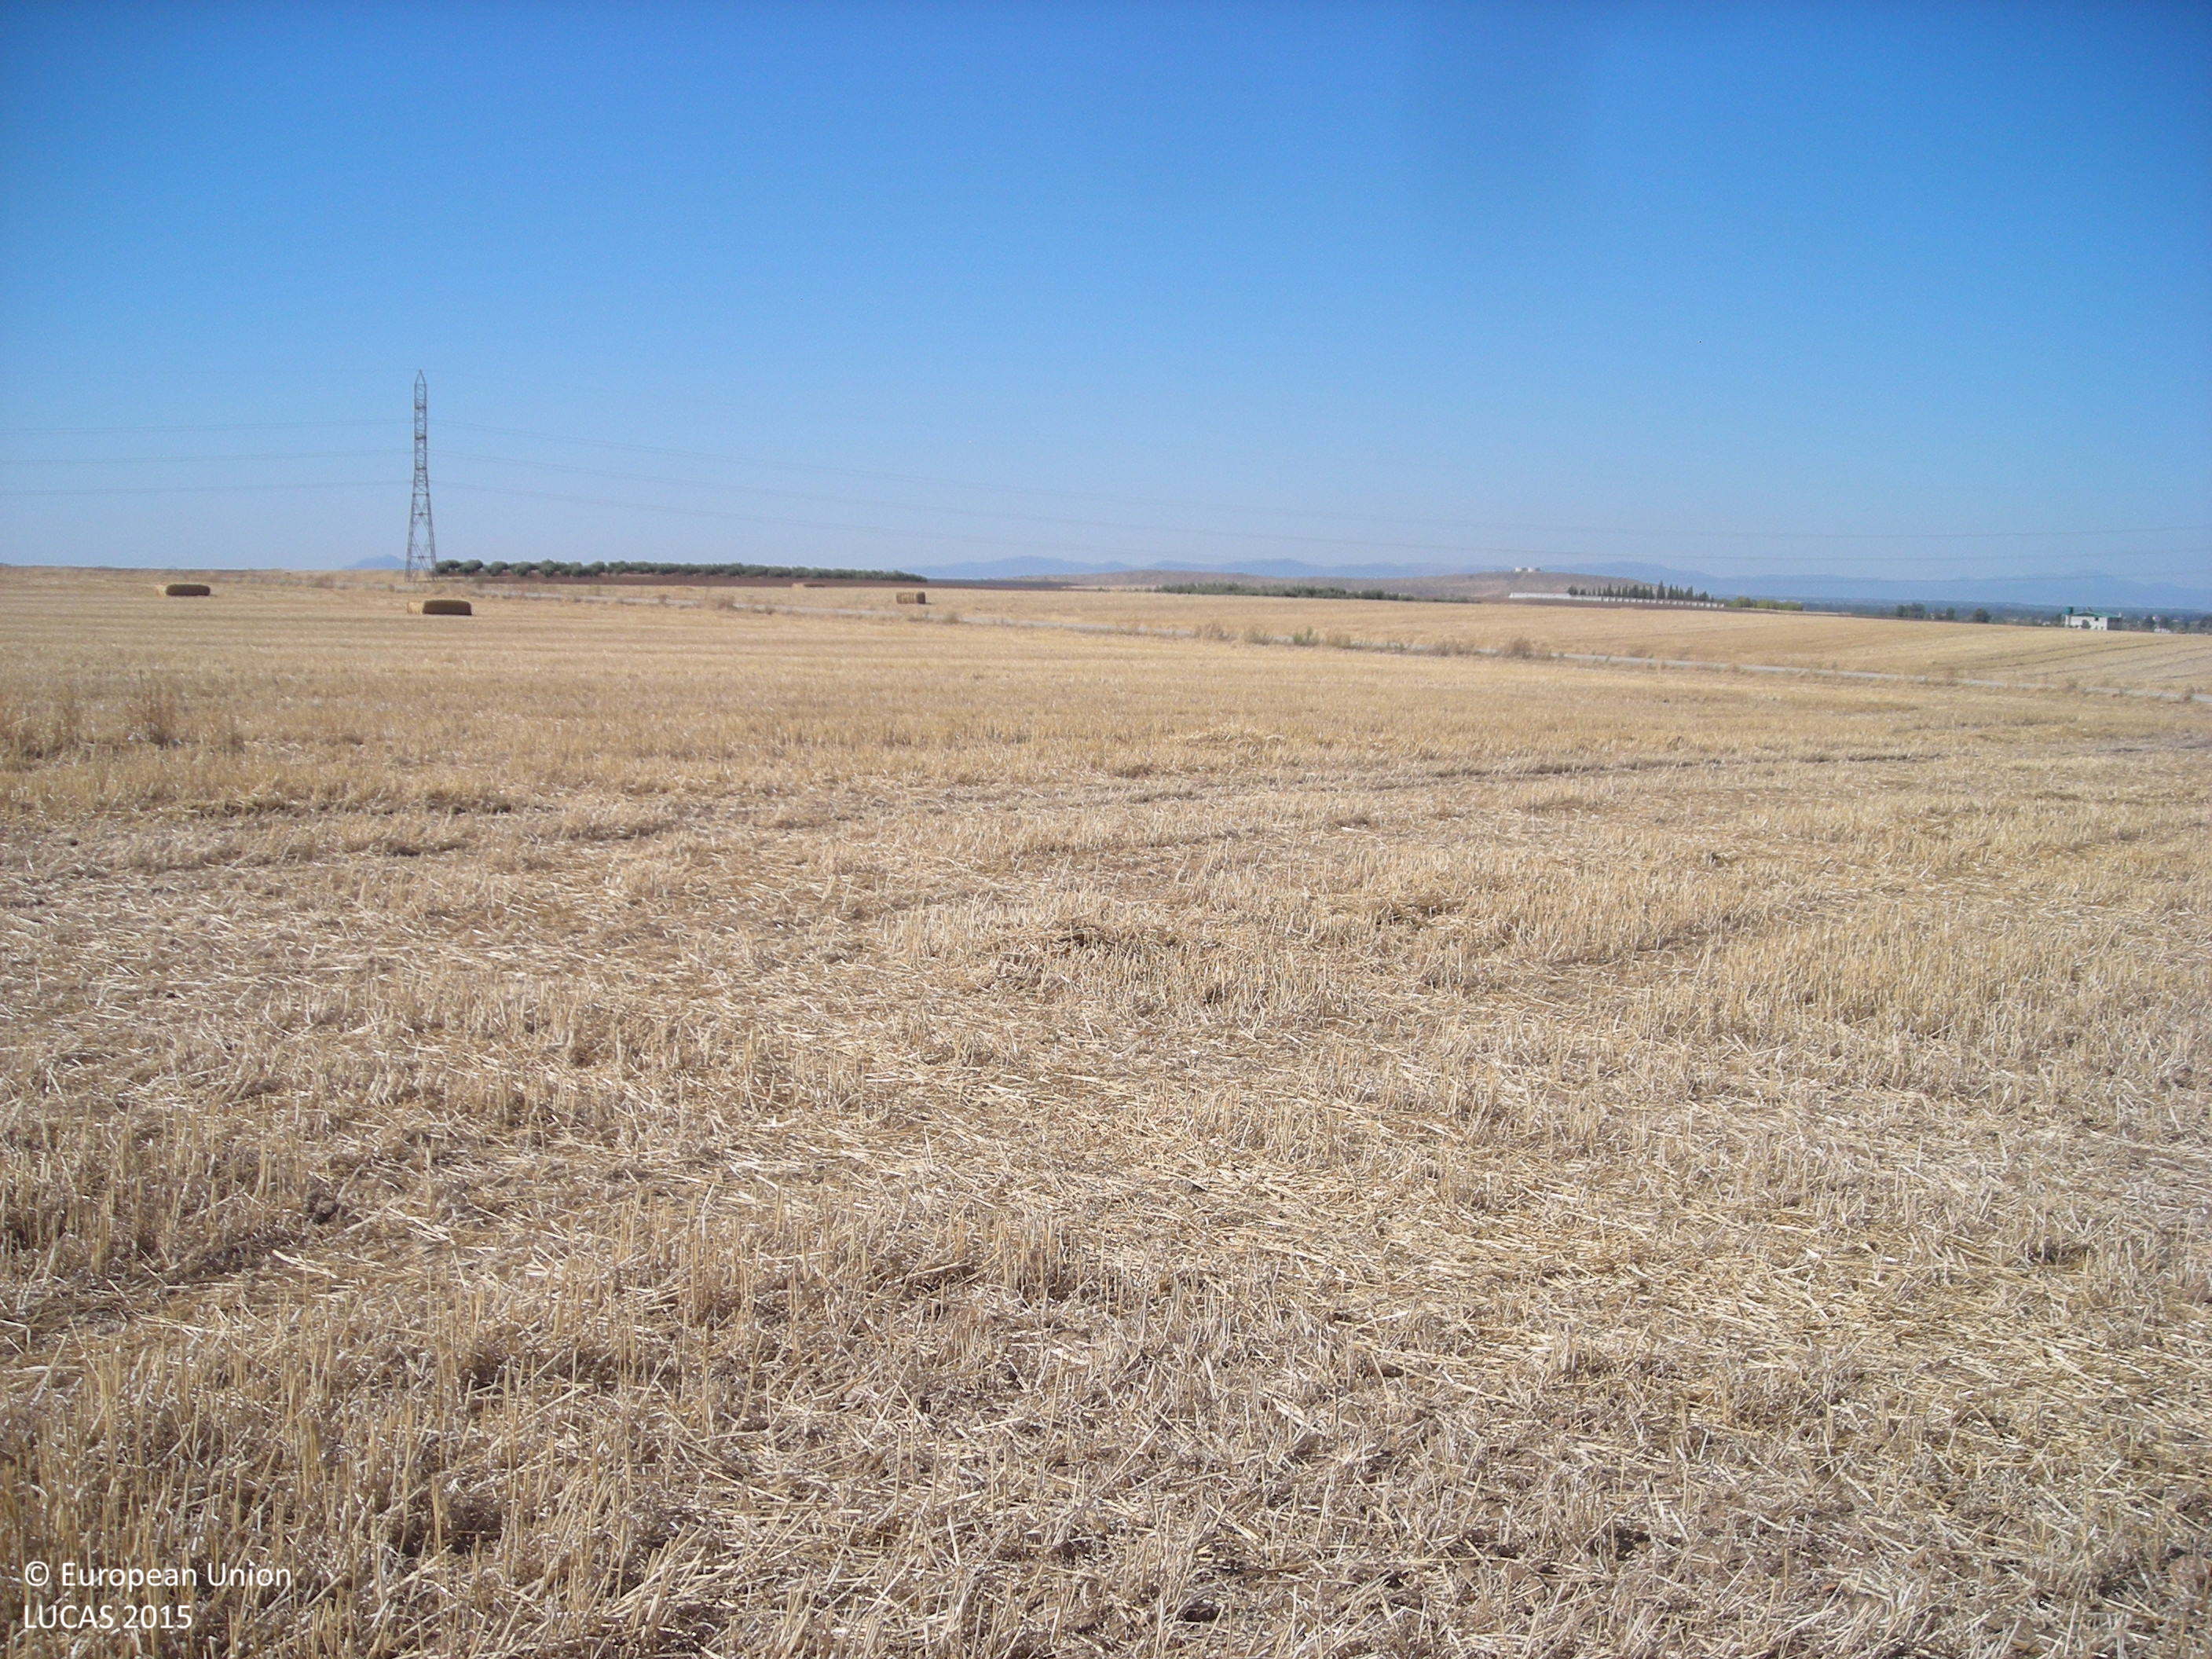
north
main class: Cropland
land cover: Common wheat
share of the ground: > 75 %
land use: Agriculture (excluding fallow land and kitchen gardens)
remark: Harvested field
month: July
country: ES
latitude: 38.9455
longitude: -5.7737
